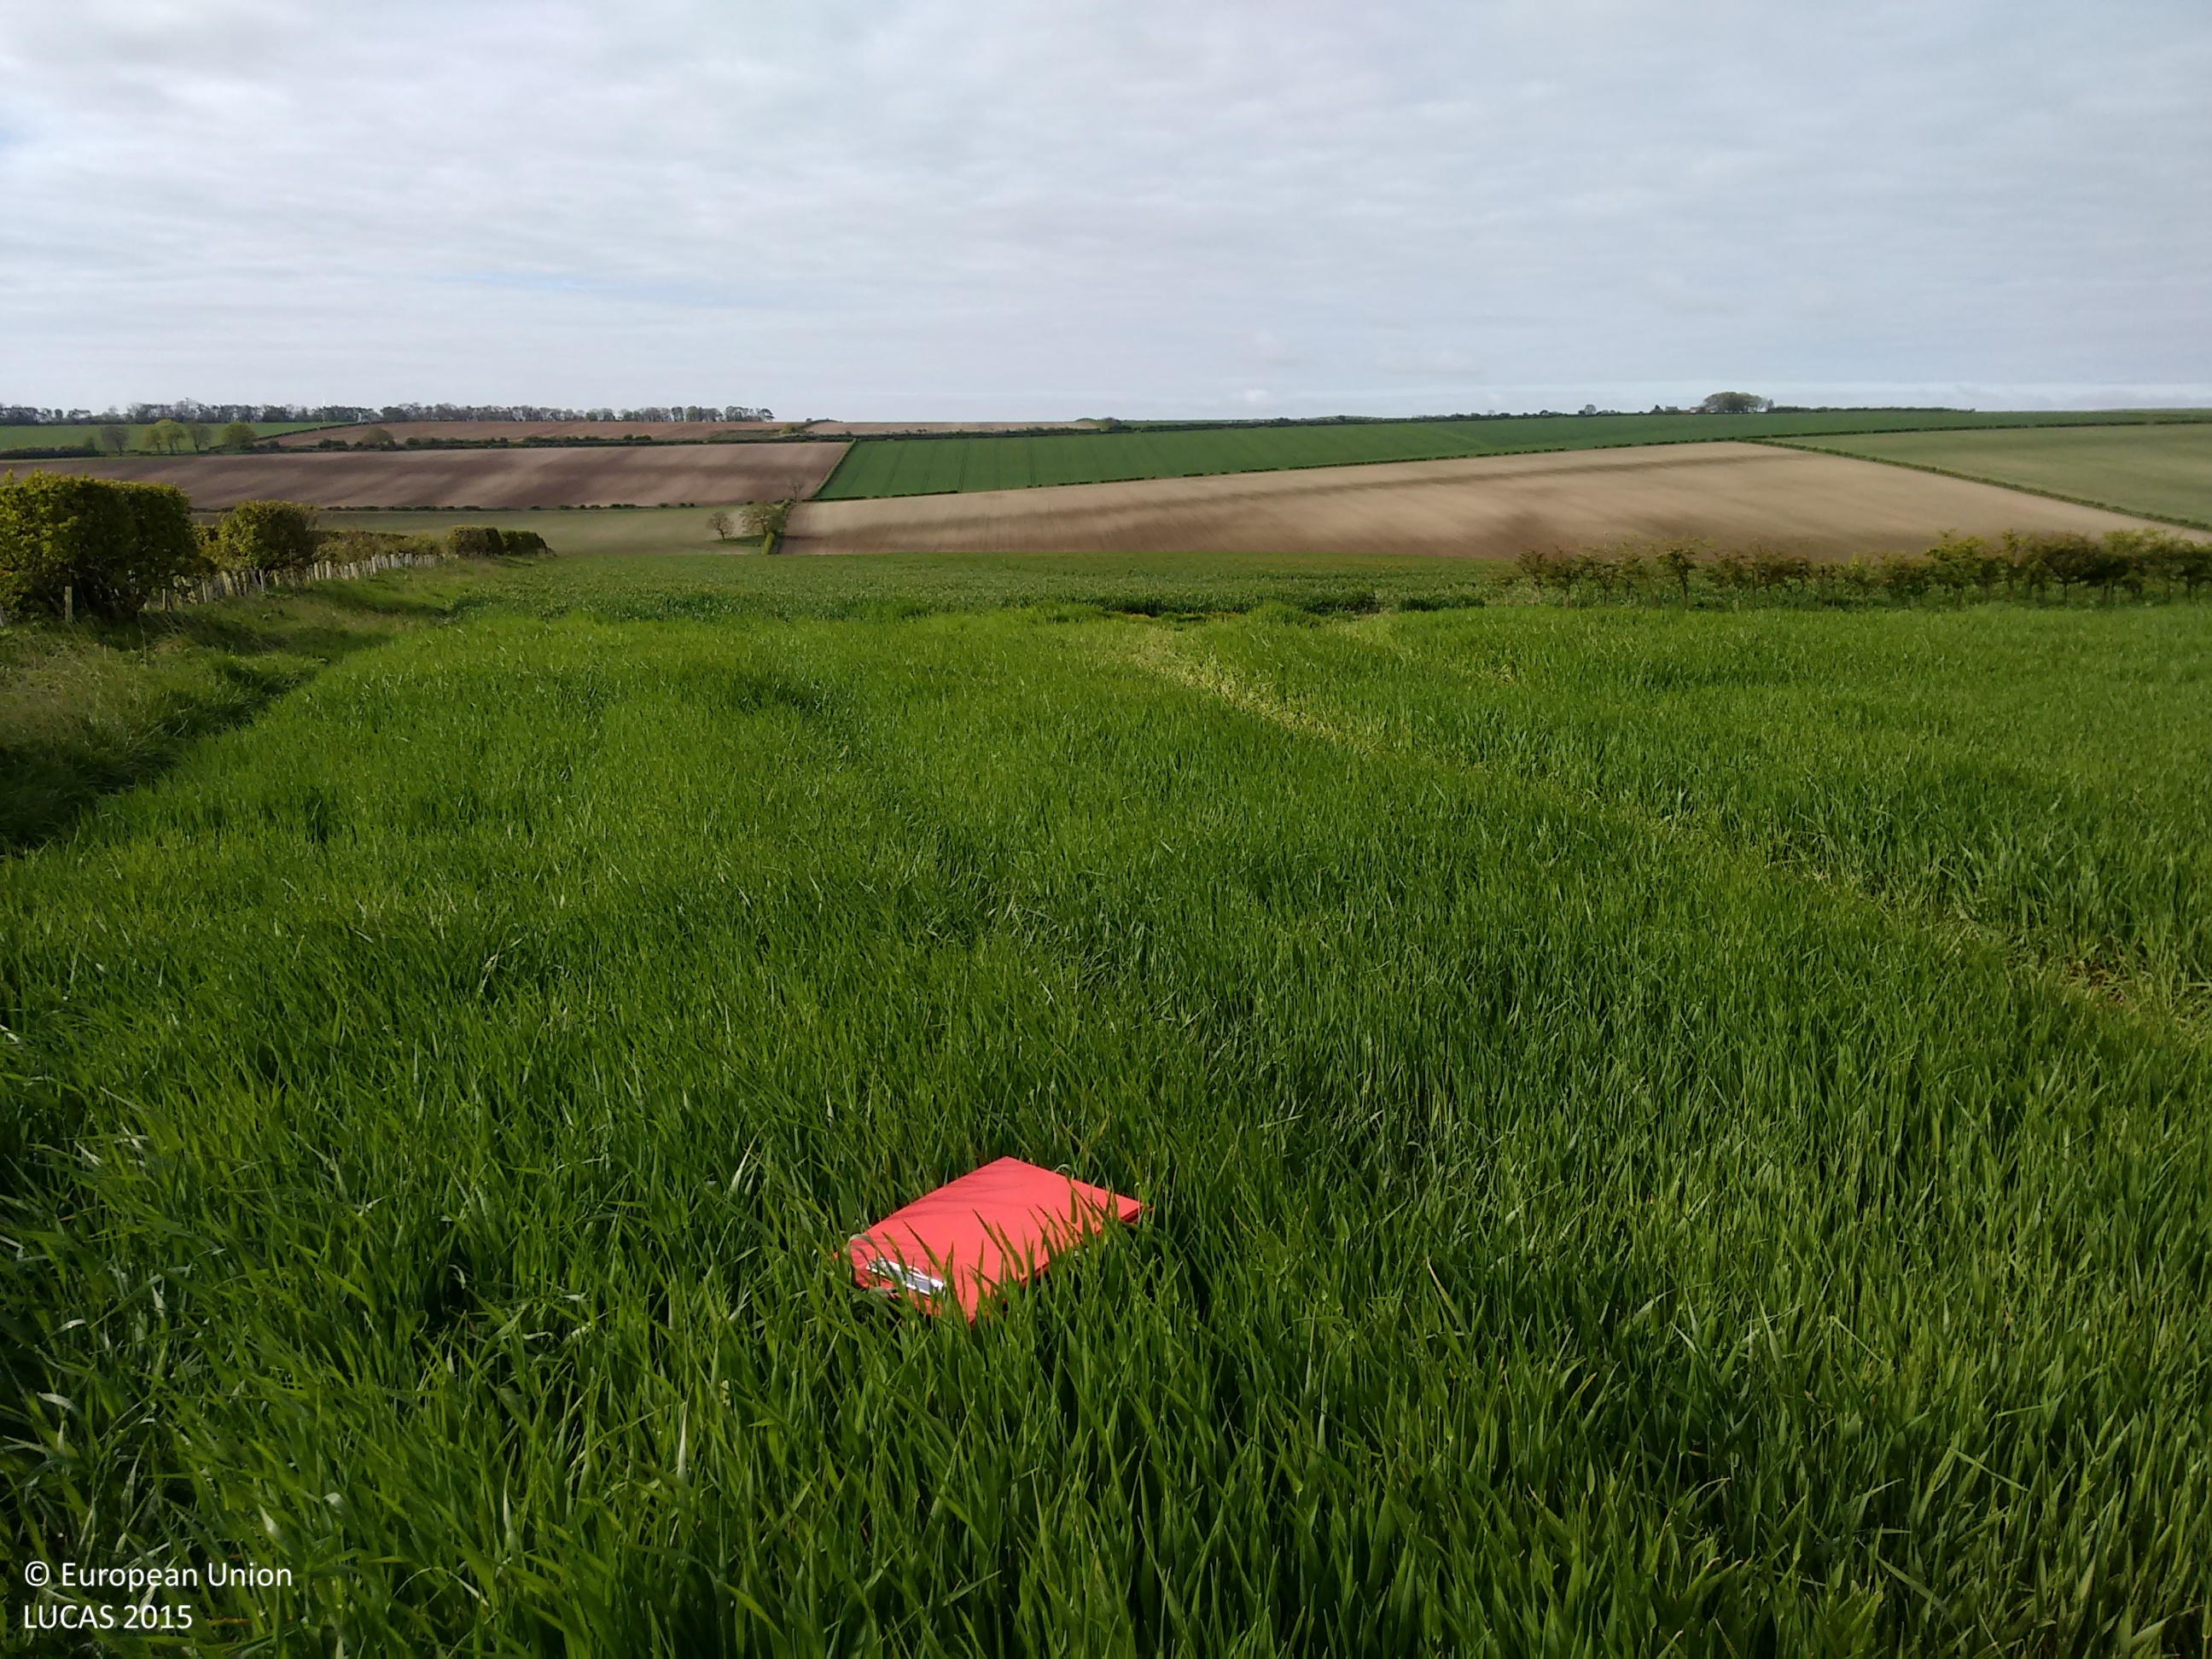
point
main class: Cropland
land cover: Barley
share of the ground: > 75 %
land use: Agriculture (excluding fallow land and kitchen gardens)
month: May
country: GB
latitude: 54.0761
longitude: -0.4129
